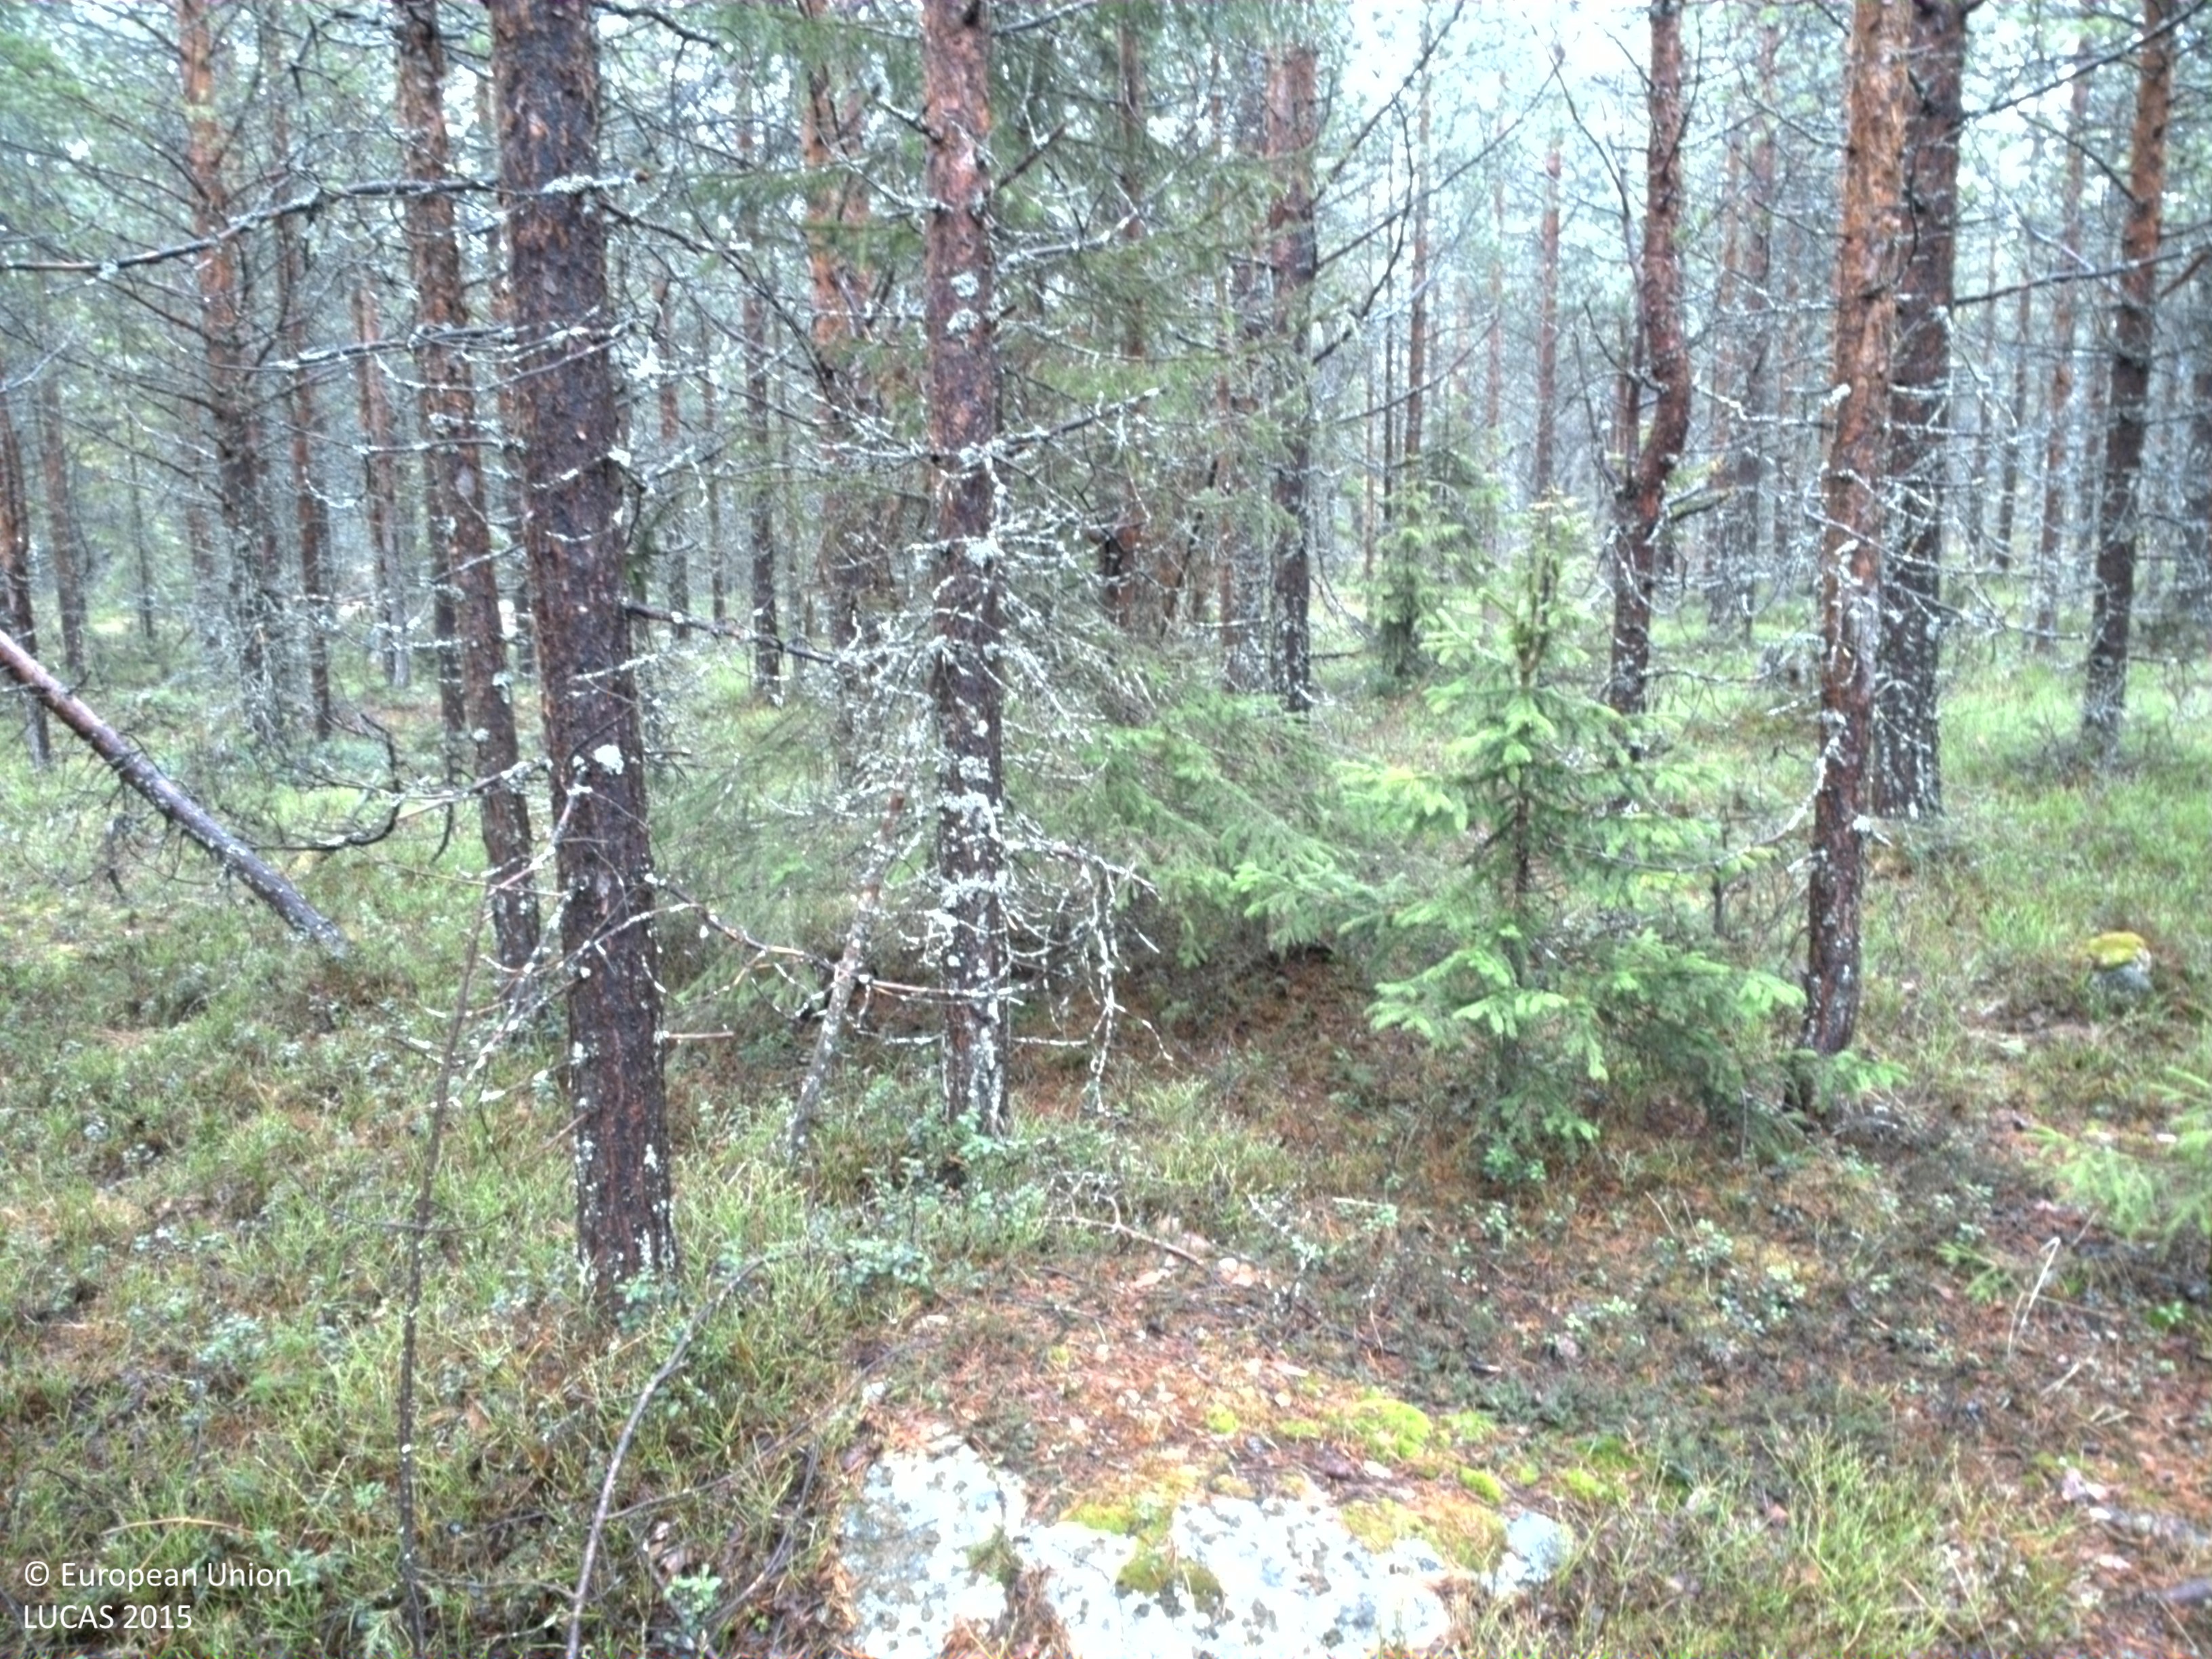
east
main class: Woodland
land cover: Pine dominated coniferous woodland
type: boreal forest
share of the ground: > 75 %
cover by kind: coniferous forest trees 75 %, shrubs 20 %, lichens and mosses 5 %
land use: Forestry
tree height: > 5 m
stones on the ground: 25 - 50 %
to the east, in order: Pine dominated coniferous woodland
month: May
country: SE
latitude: 66.2437
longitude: 23.3101
